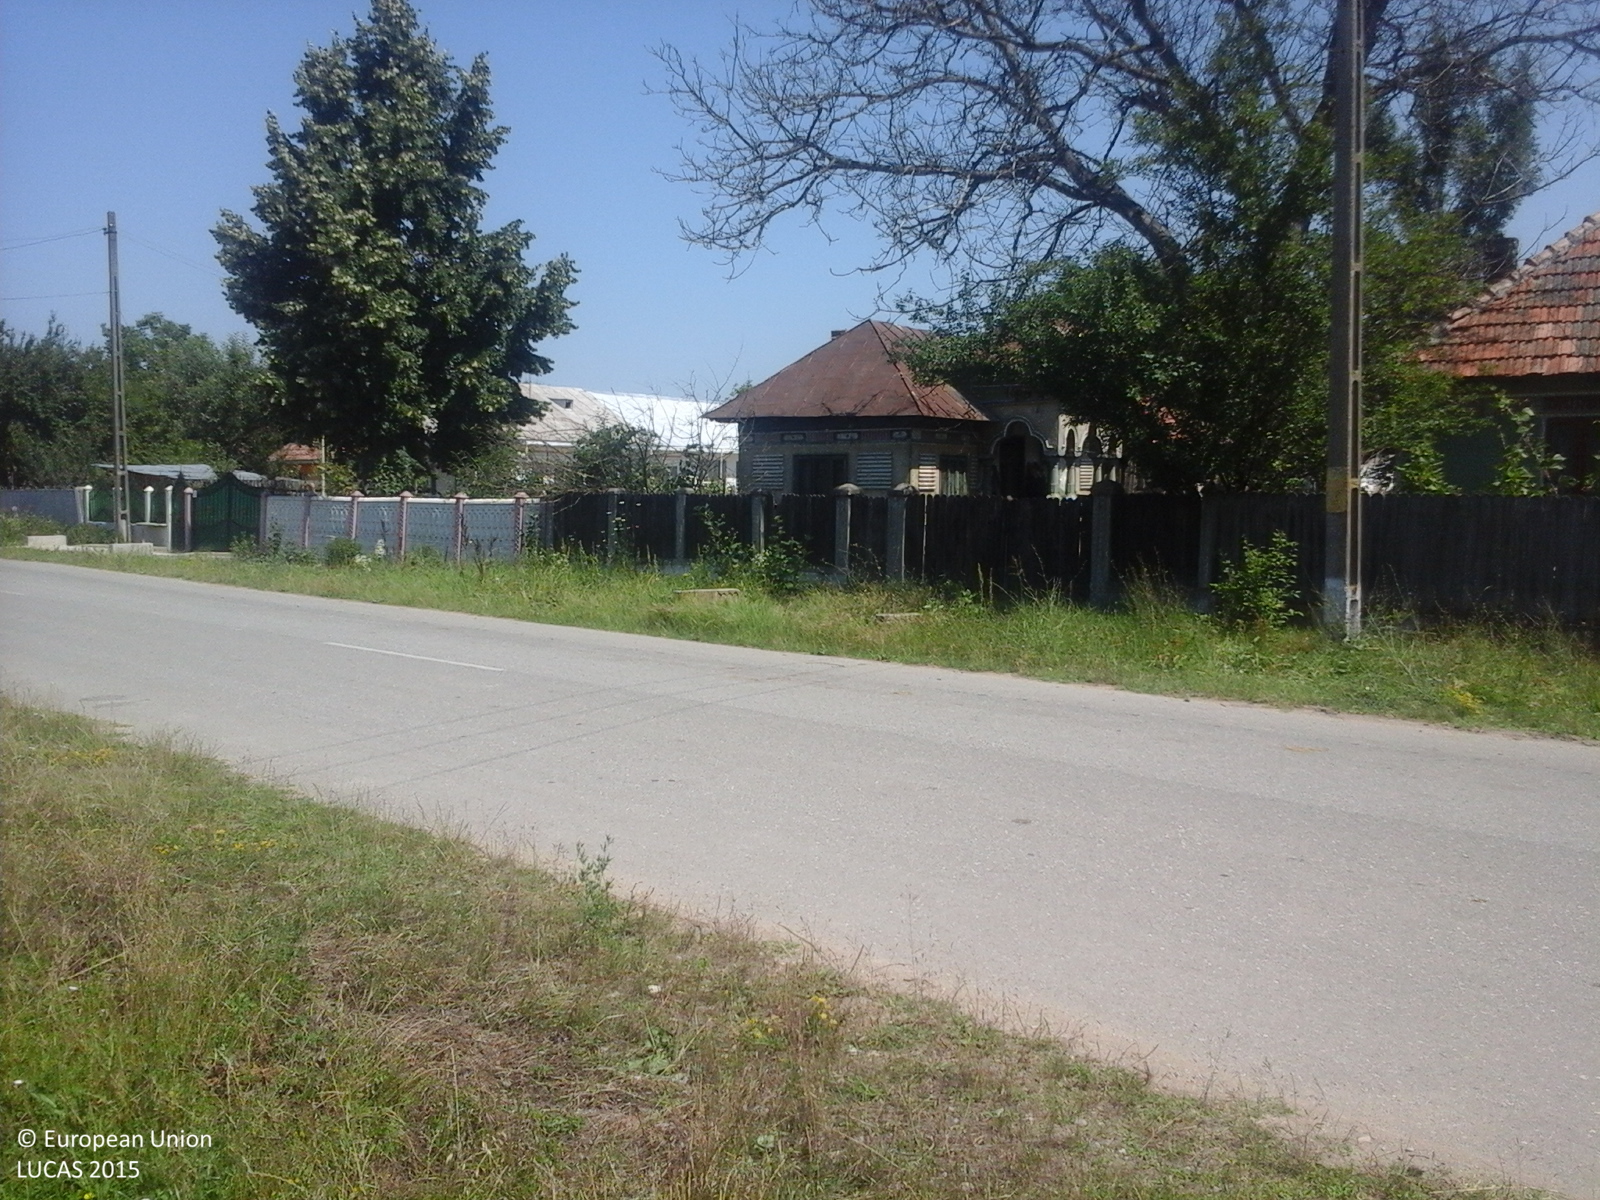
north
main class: Cropland
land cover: Maize
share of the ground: > 75 %
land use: Agriculture (excluding fallow land and kitchen gardens)
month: July
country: RO
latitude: 44.5776
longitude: 24.1833
